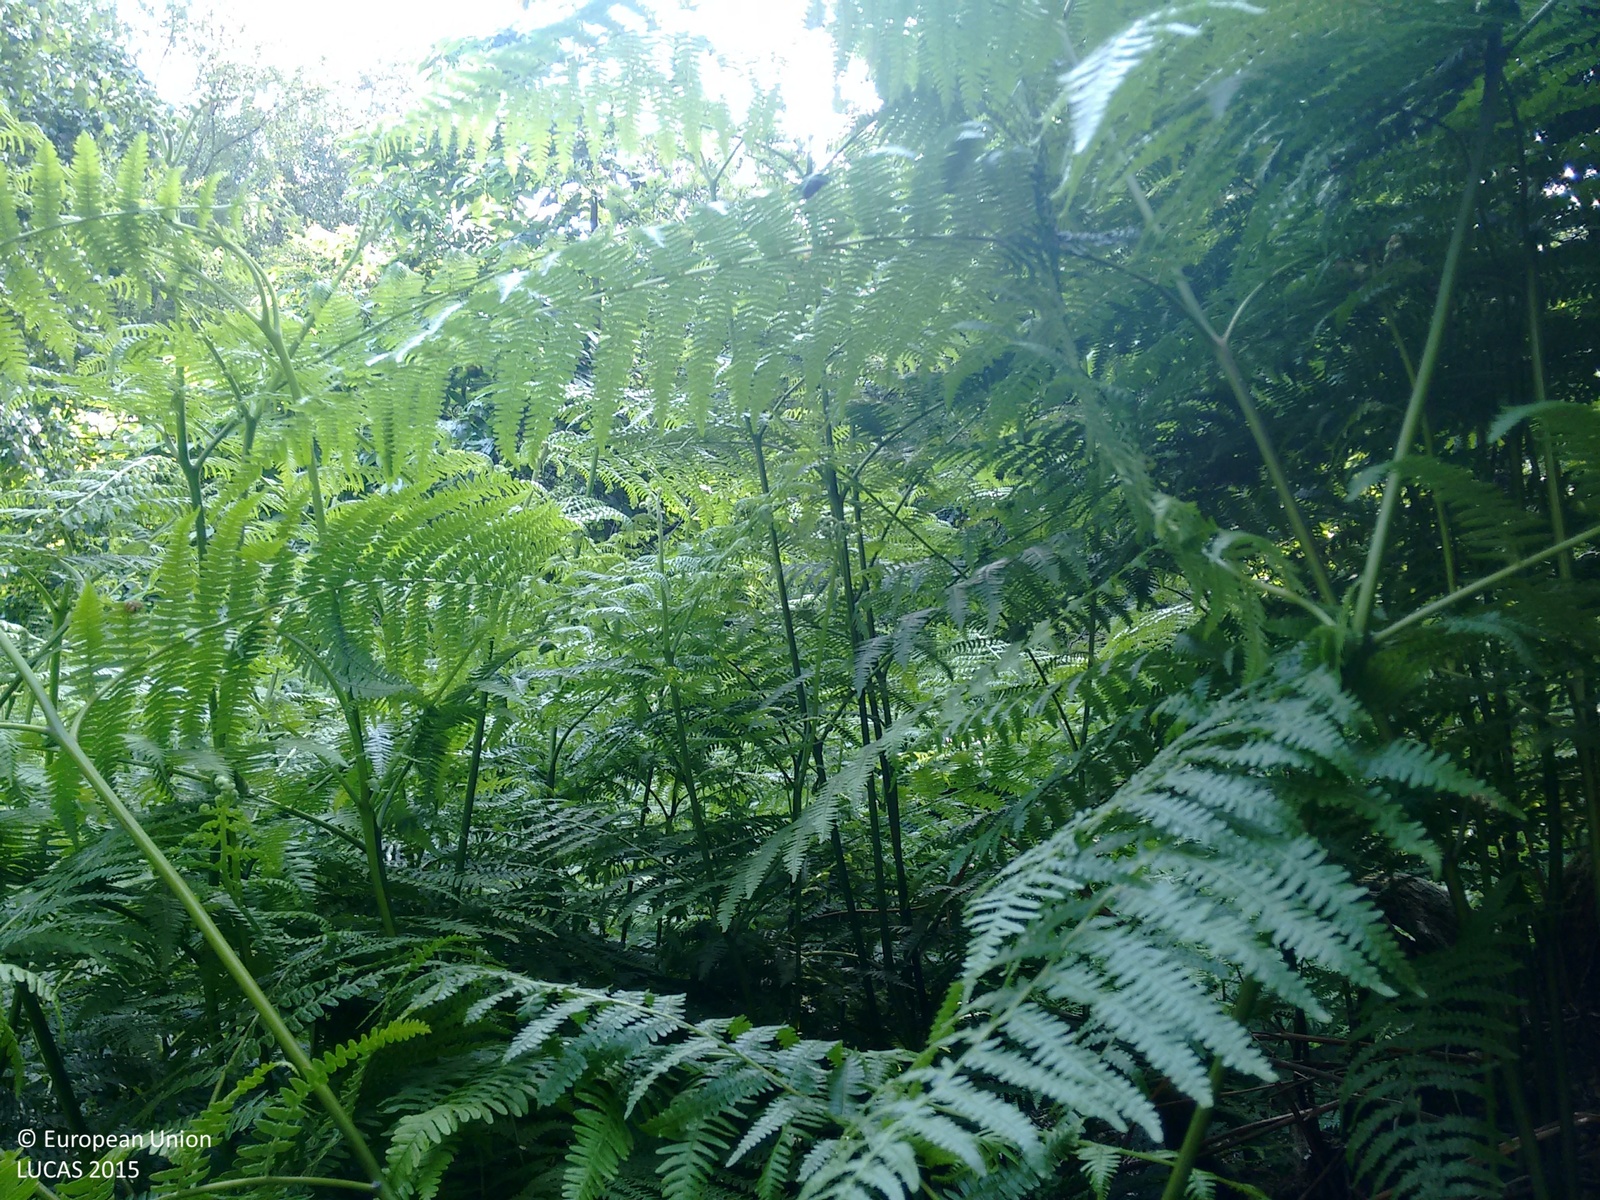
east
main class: Woodland
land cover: Broadleaved woodland
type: mesophytic deciduous forest
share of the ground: 50 - 75 %
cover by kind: broadleaved forest trees 70 %, herbaceous plants 20 %, shrubs 10 %
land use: Forestry
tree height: > 5 m
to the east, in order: Broadleaved woodland; Tracks; Spruce dominated mixed woodland; Tracks; Broadleaved woodland
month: June
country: GB
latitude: 50.9012
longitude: 0.4016
